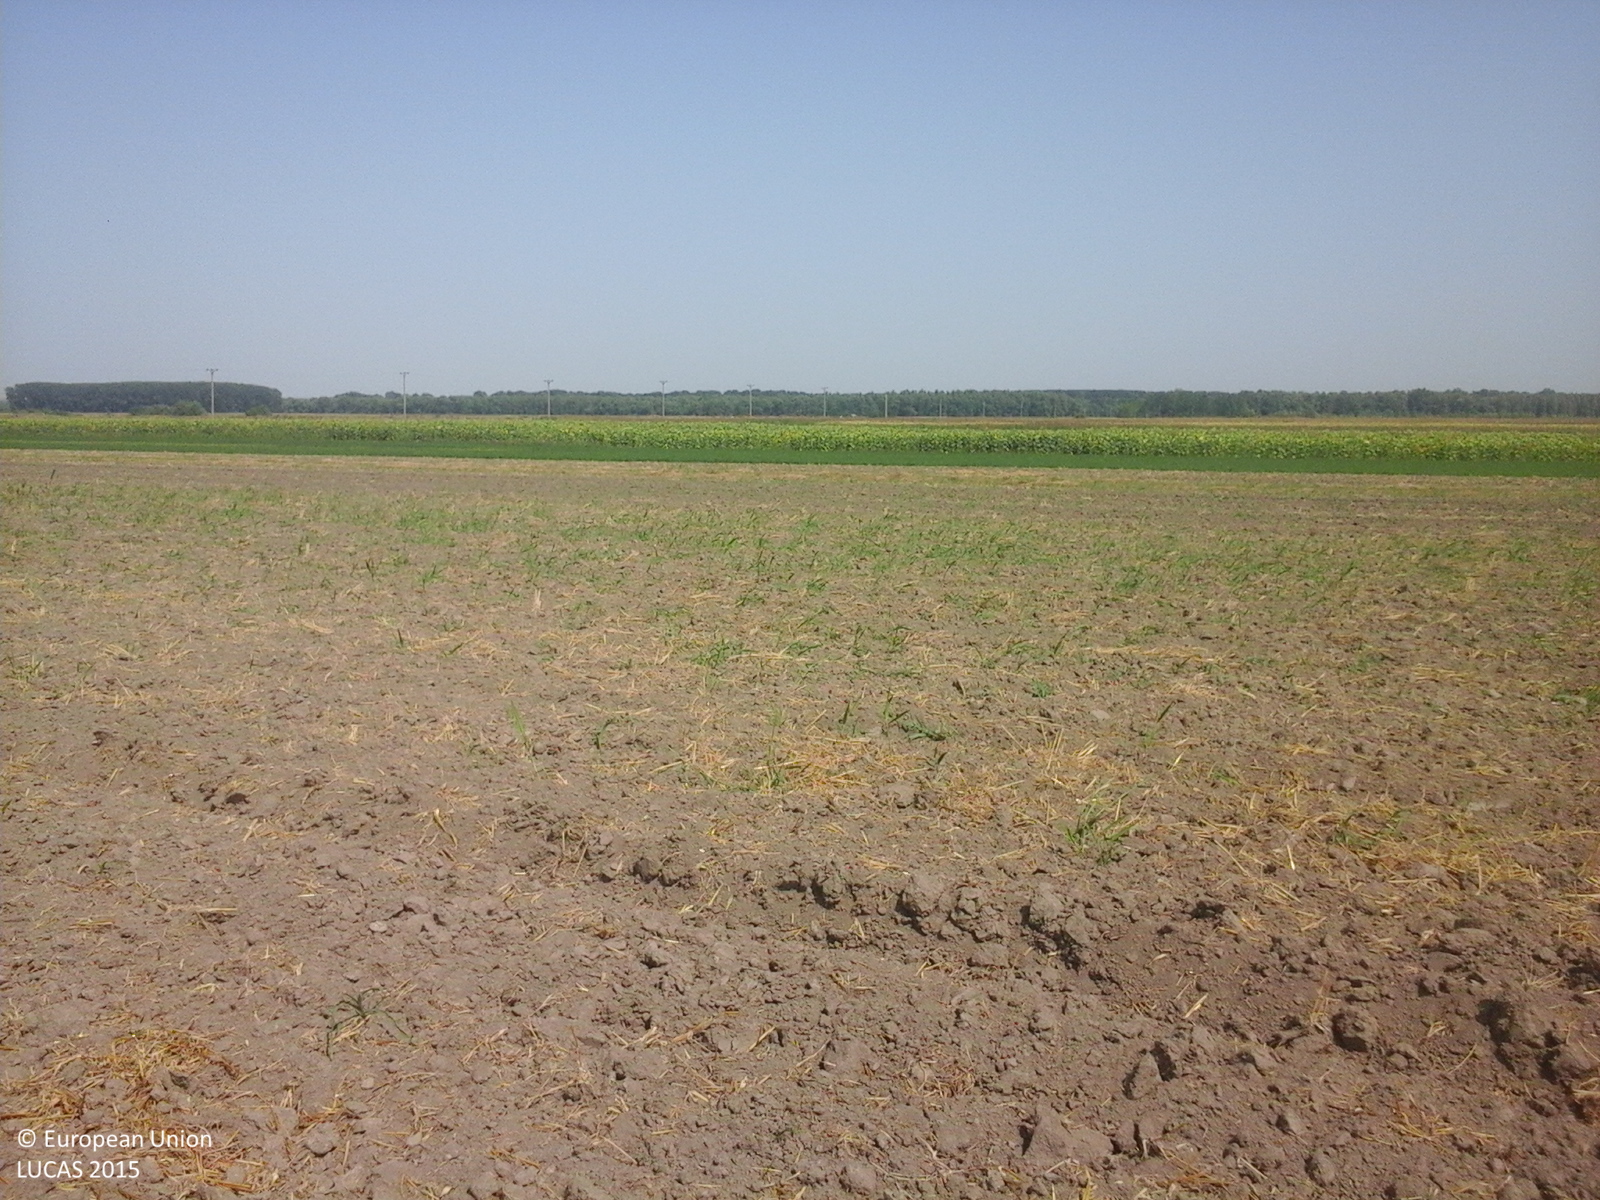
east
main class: Cropland
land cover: Durum wheat
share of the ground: < 10 %
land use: Agriculture (excluding fallow land and kitchen gardens)
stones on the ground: < 10 %
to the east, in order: Durum wheat; Lucerne; Sunflower; Rape and turnip rape; Lucerne; Rape and turnip rape
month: August
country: RO
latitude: 44.8162
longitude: 28.0567
